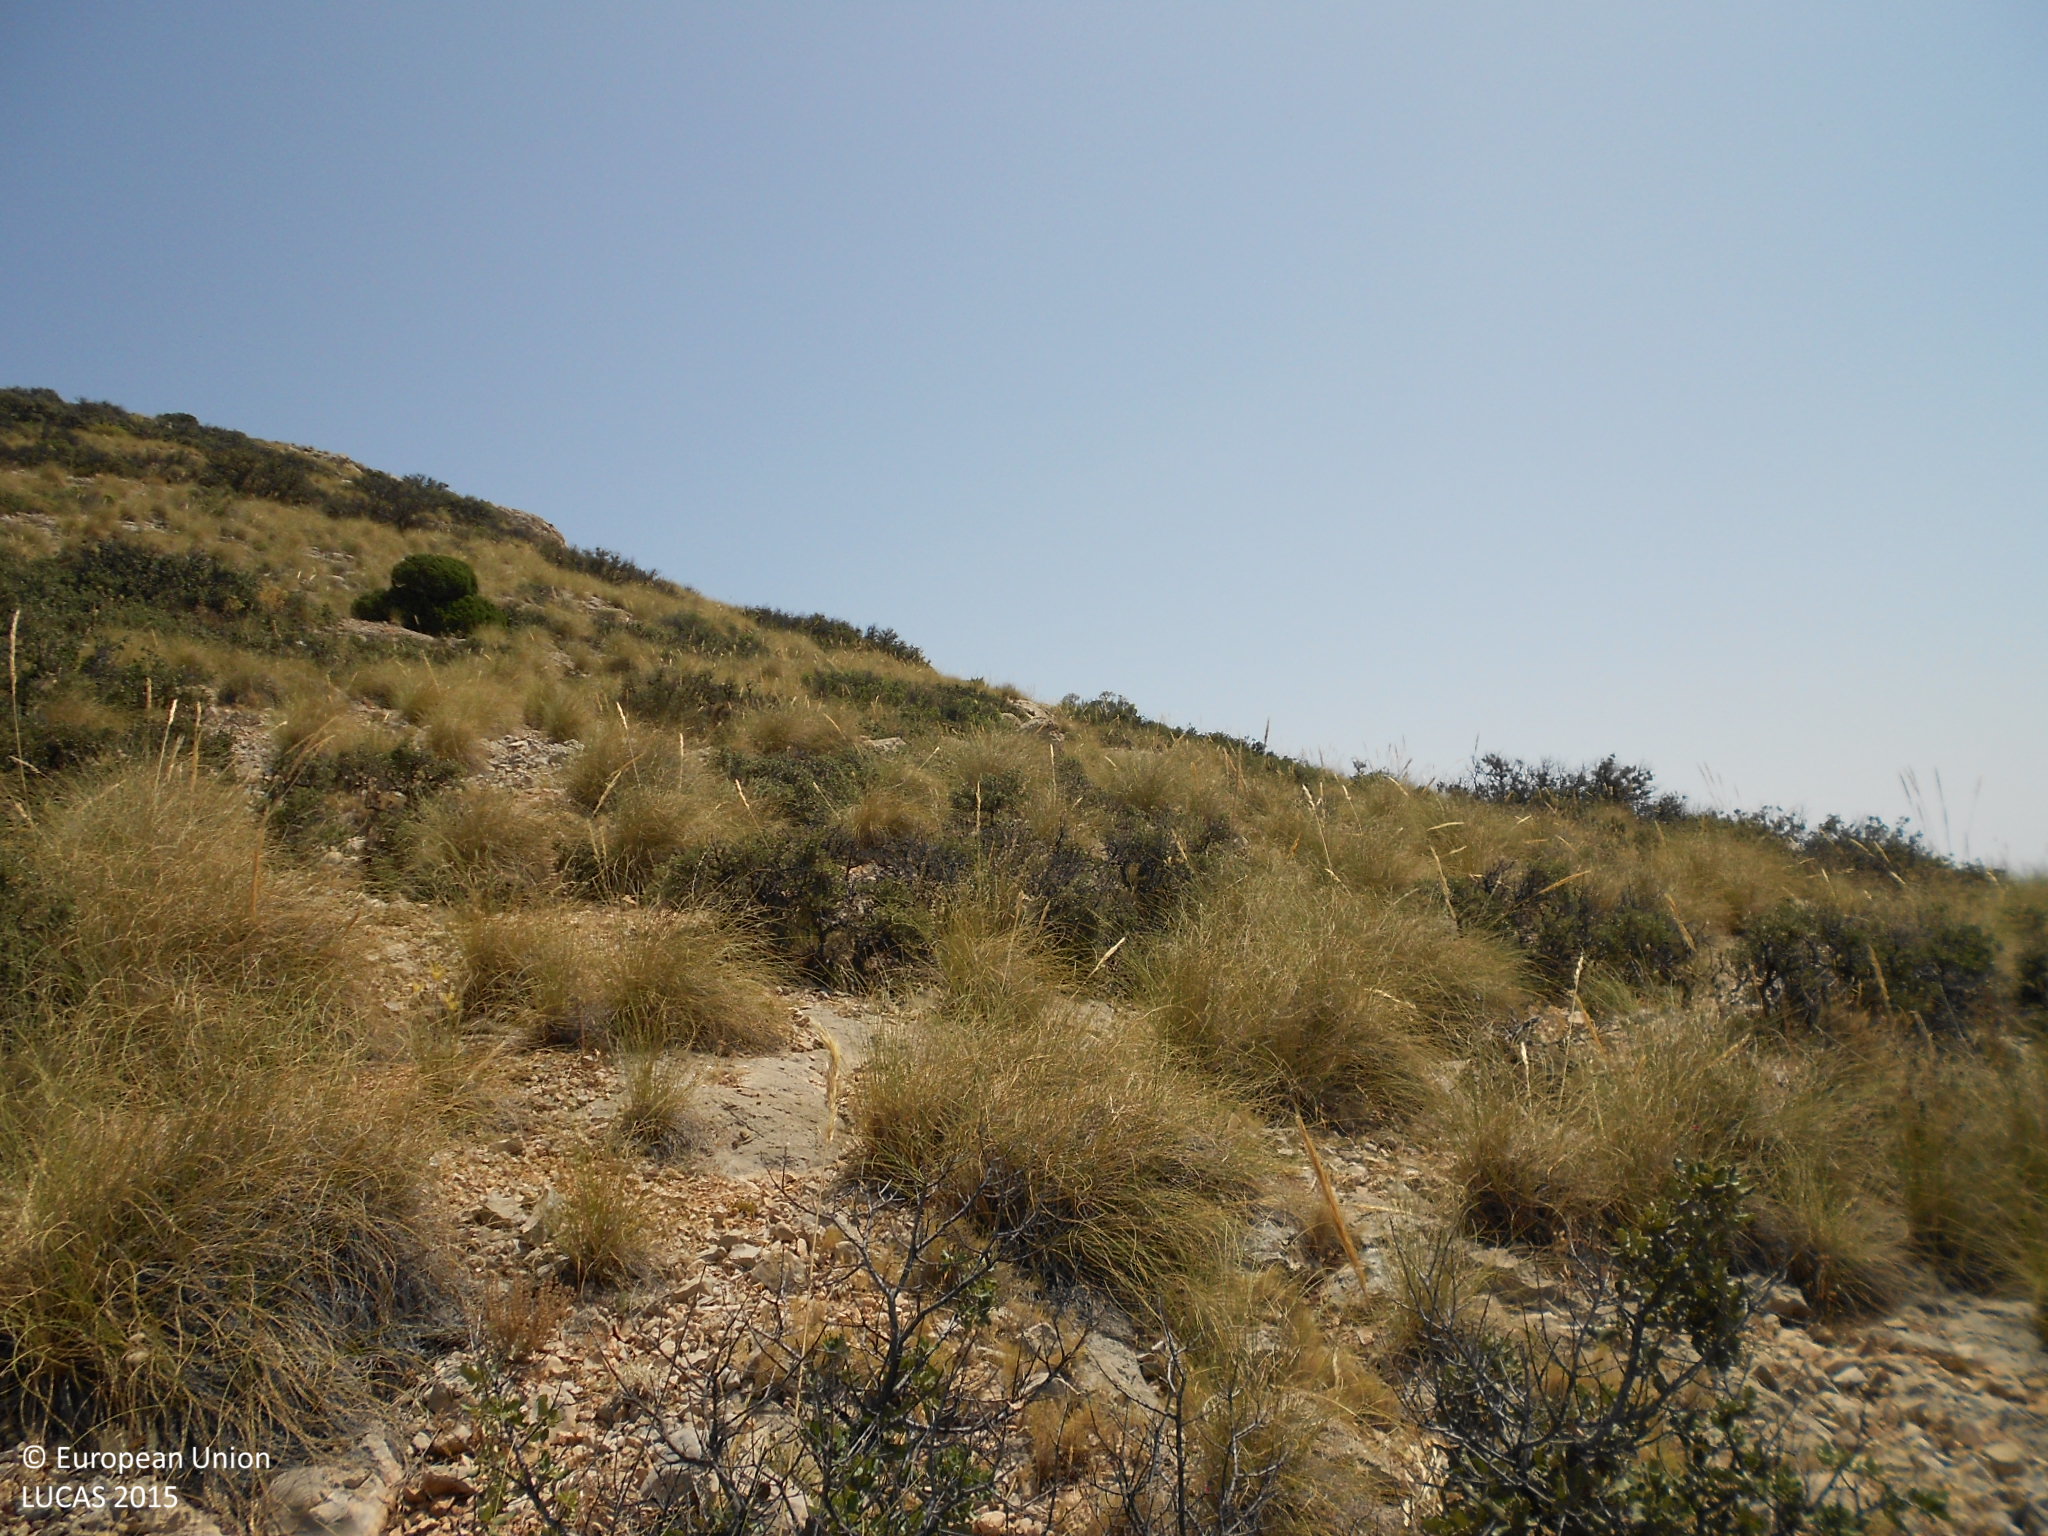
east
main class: Shrubland
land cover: Shrubland without tree cover
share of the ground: 50 - 75 %
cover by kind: shrubs 60 %, herbaceous plants 20 %, consolidated bare surface 20 %
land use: Semi-natural and natural areas not in use
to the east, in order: Shrubland without tree cover
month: July
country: ES
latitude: 37.6322
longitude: -2.2347
